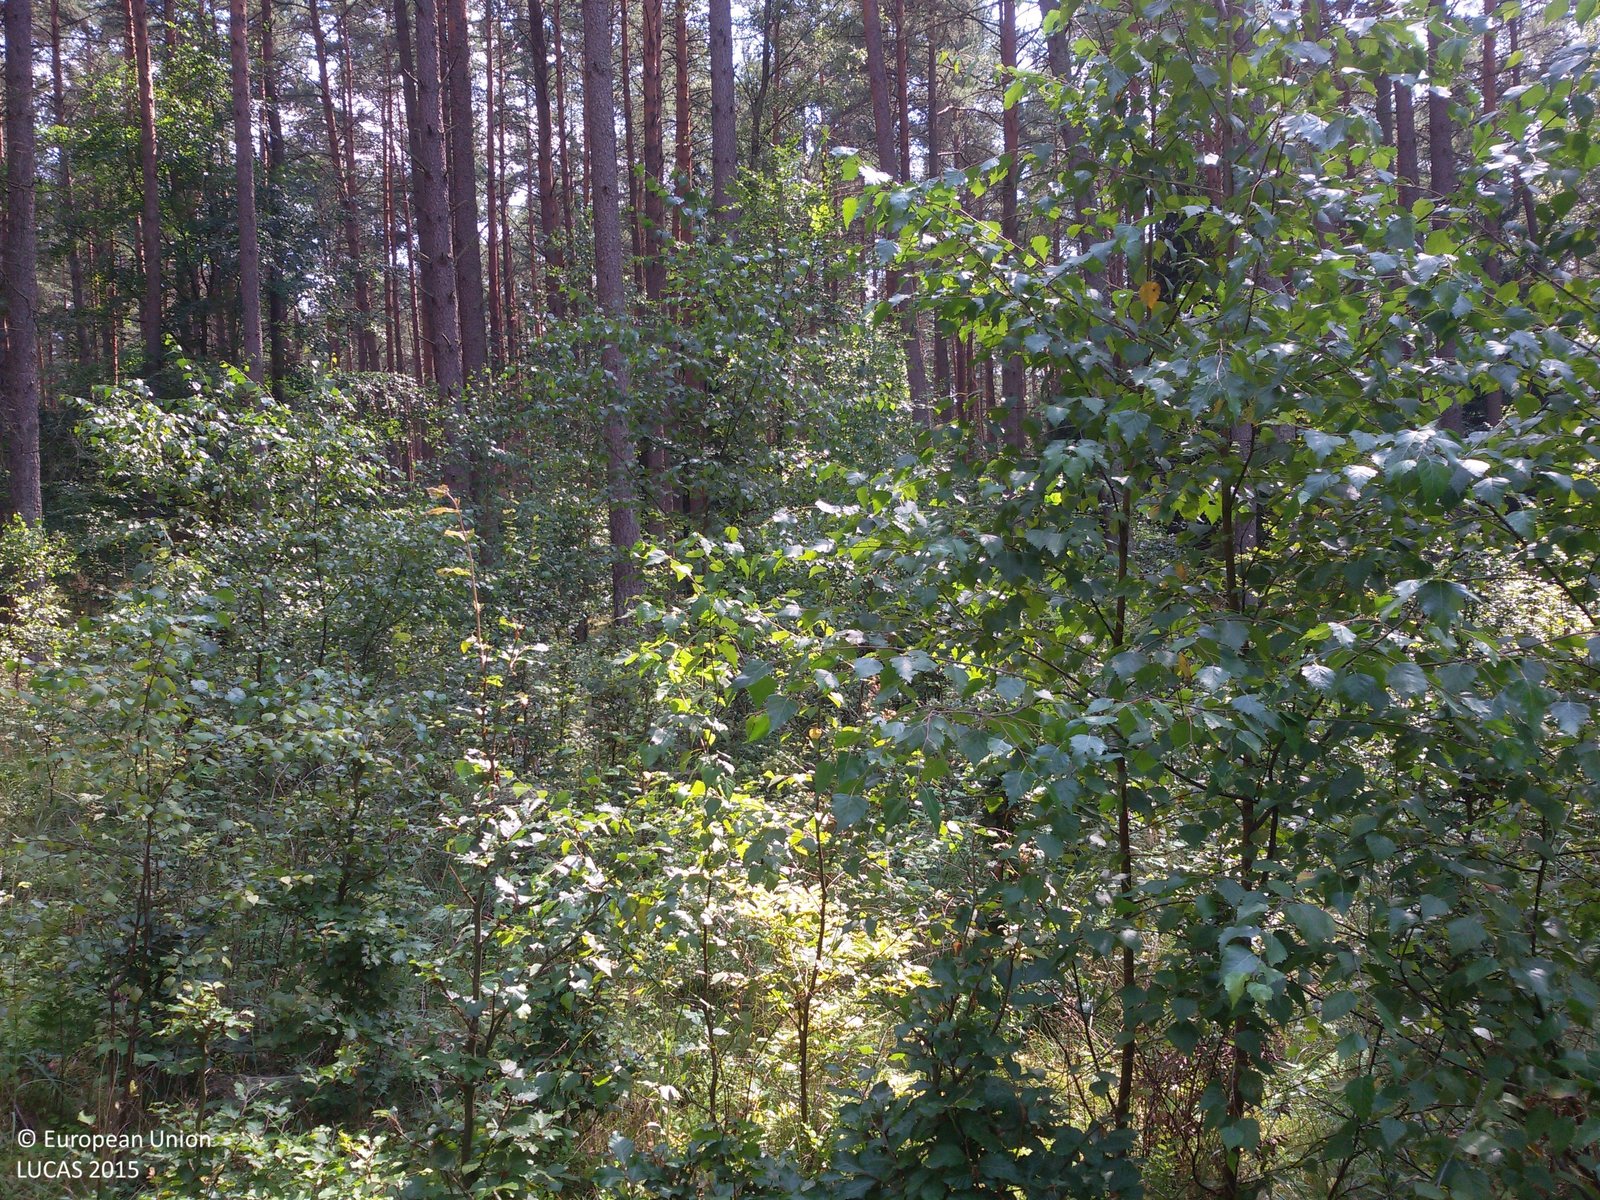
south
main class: Woodland
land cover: Broadleaved woodland
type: mesophytic deciduous forest
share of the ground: > 75 %
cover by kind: broadleaved forest trees 75 %, herbaceous plants 25 %
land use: Forestry
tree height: > 5 m
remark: Nursery
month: August
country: PL
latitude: 53.7308
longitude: 17.7587
